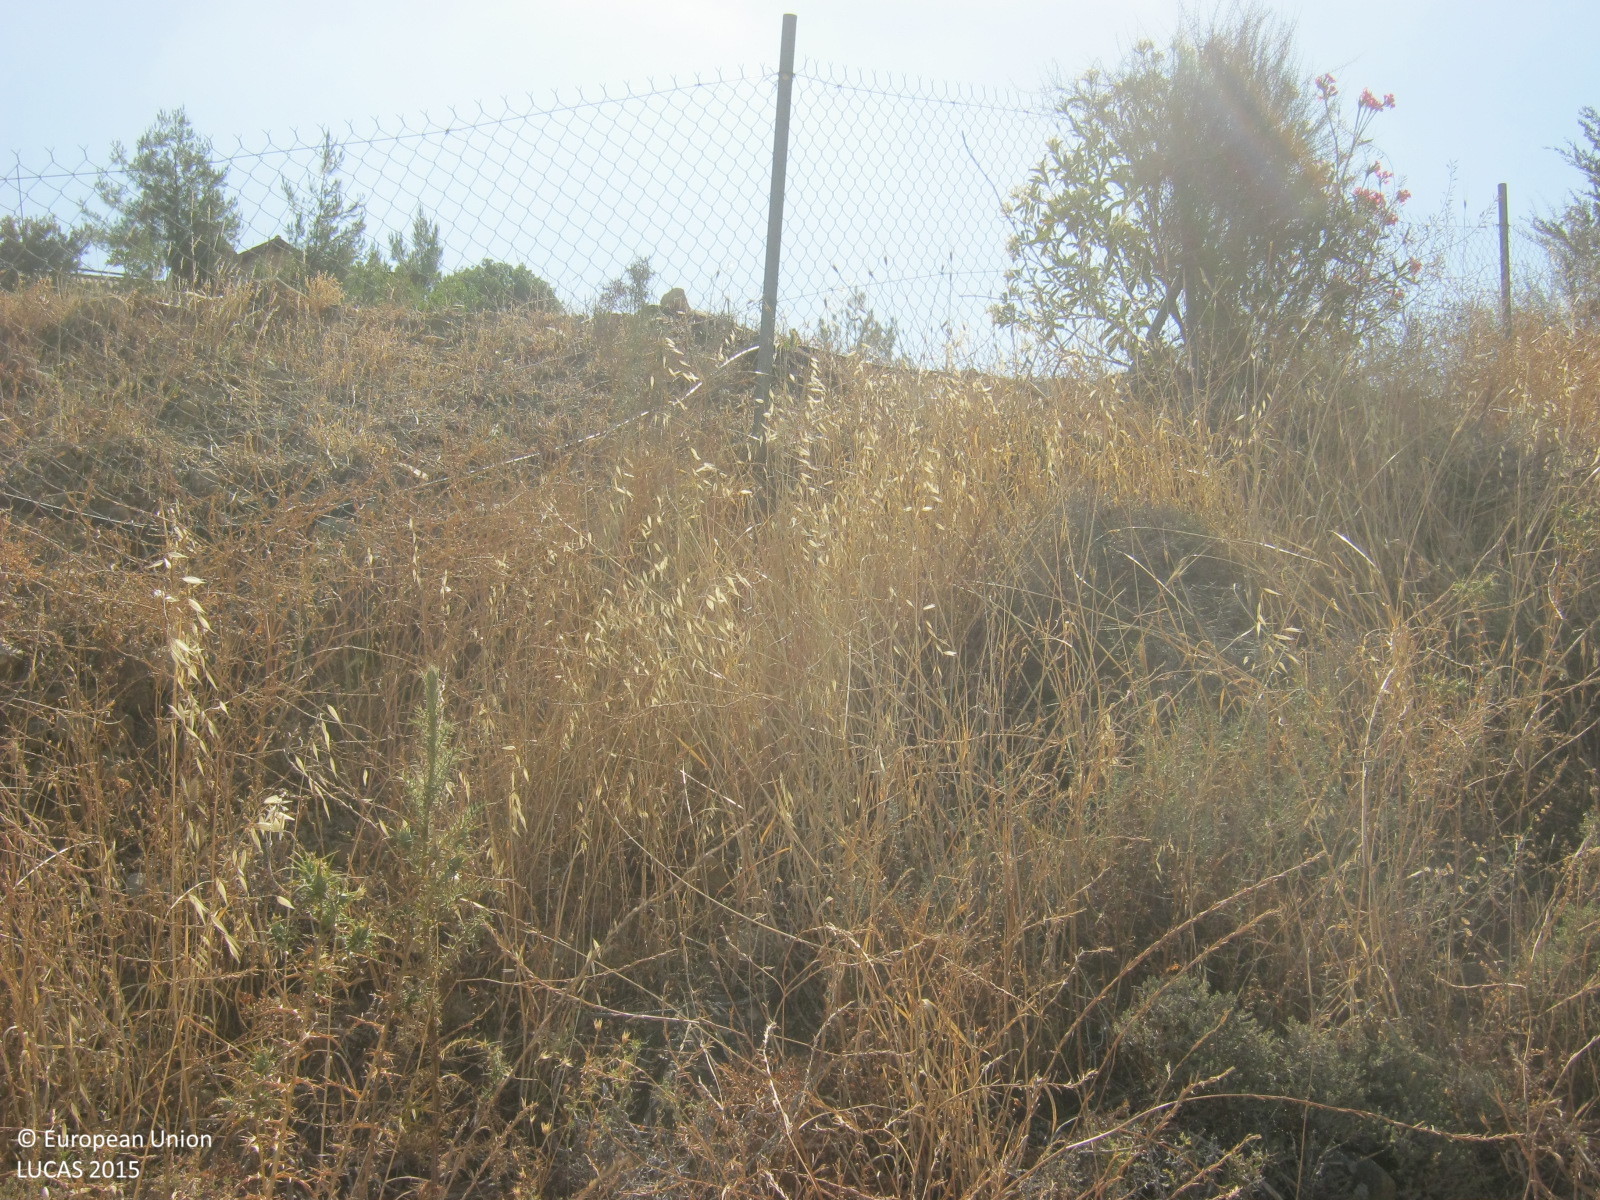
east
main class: Shrubland
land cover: Shrubland without tree cover
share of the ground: 25 - 50 %
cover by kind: herbaceous plants 55 %, shrubs 35 %, unconsolidated bare surface 10 %
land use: Semi-natural and natural areas not in use
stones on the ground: 25 - 50 %
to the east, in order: Shrubland without tree cover; Fences; Managed hedges; Grass margins; Tracks; Grassland with sparse tree/shrub cover; Fences; Grassland with sparse tree/shrub cover; Other bare soil; Lines of trees; Grass margins; Paved roads, cycling and walking lanes; Fences; Grass margins; Olive groves
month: May
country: CY
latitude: 35.0703
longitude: 33.0194
